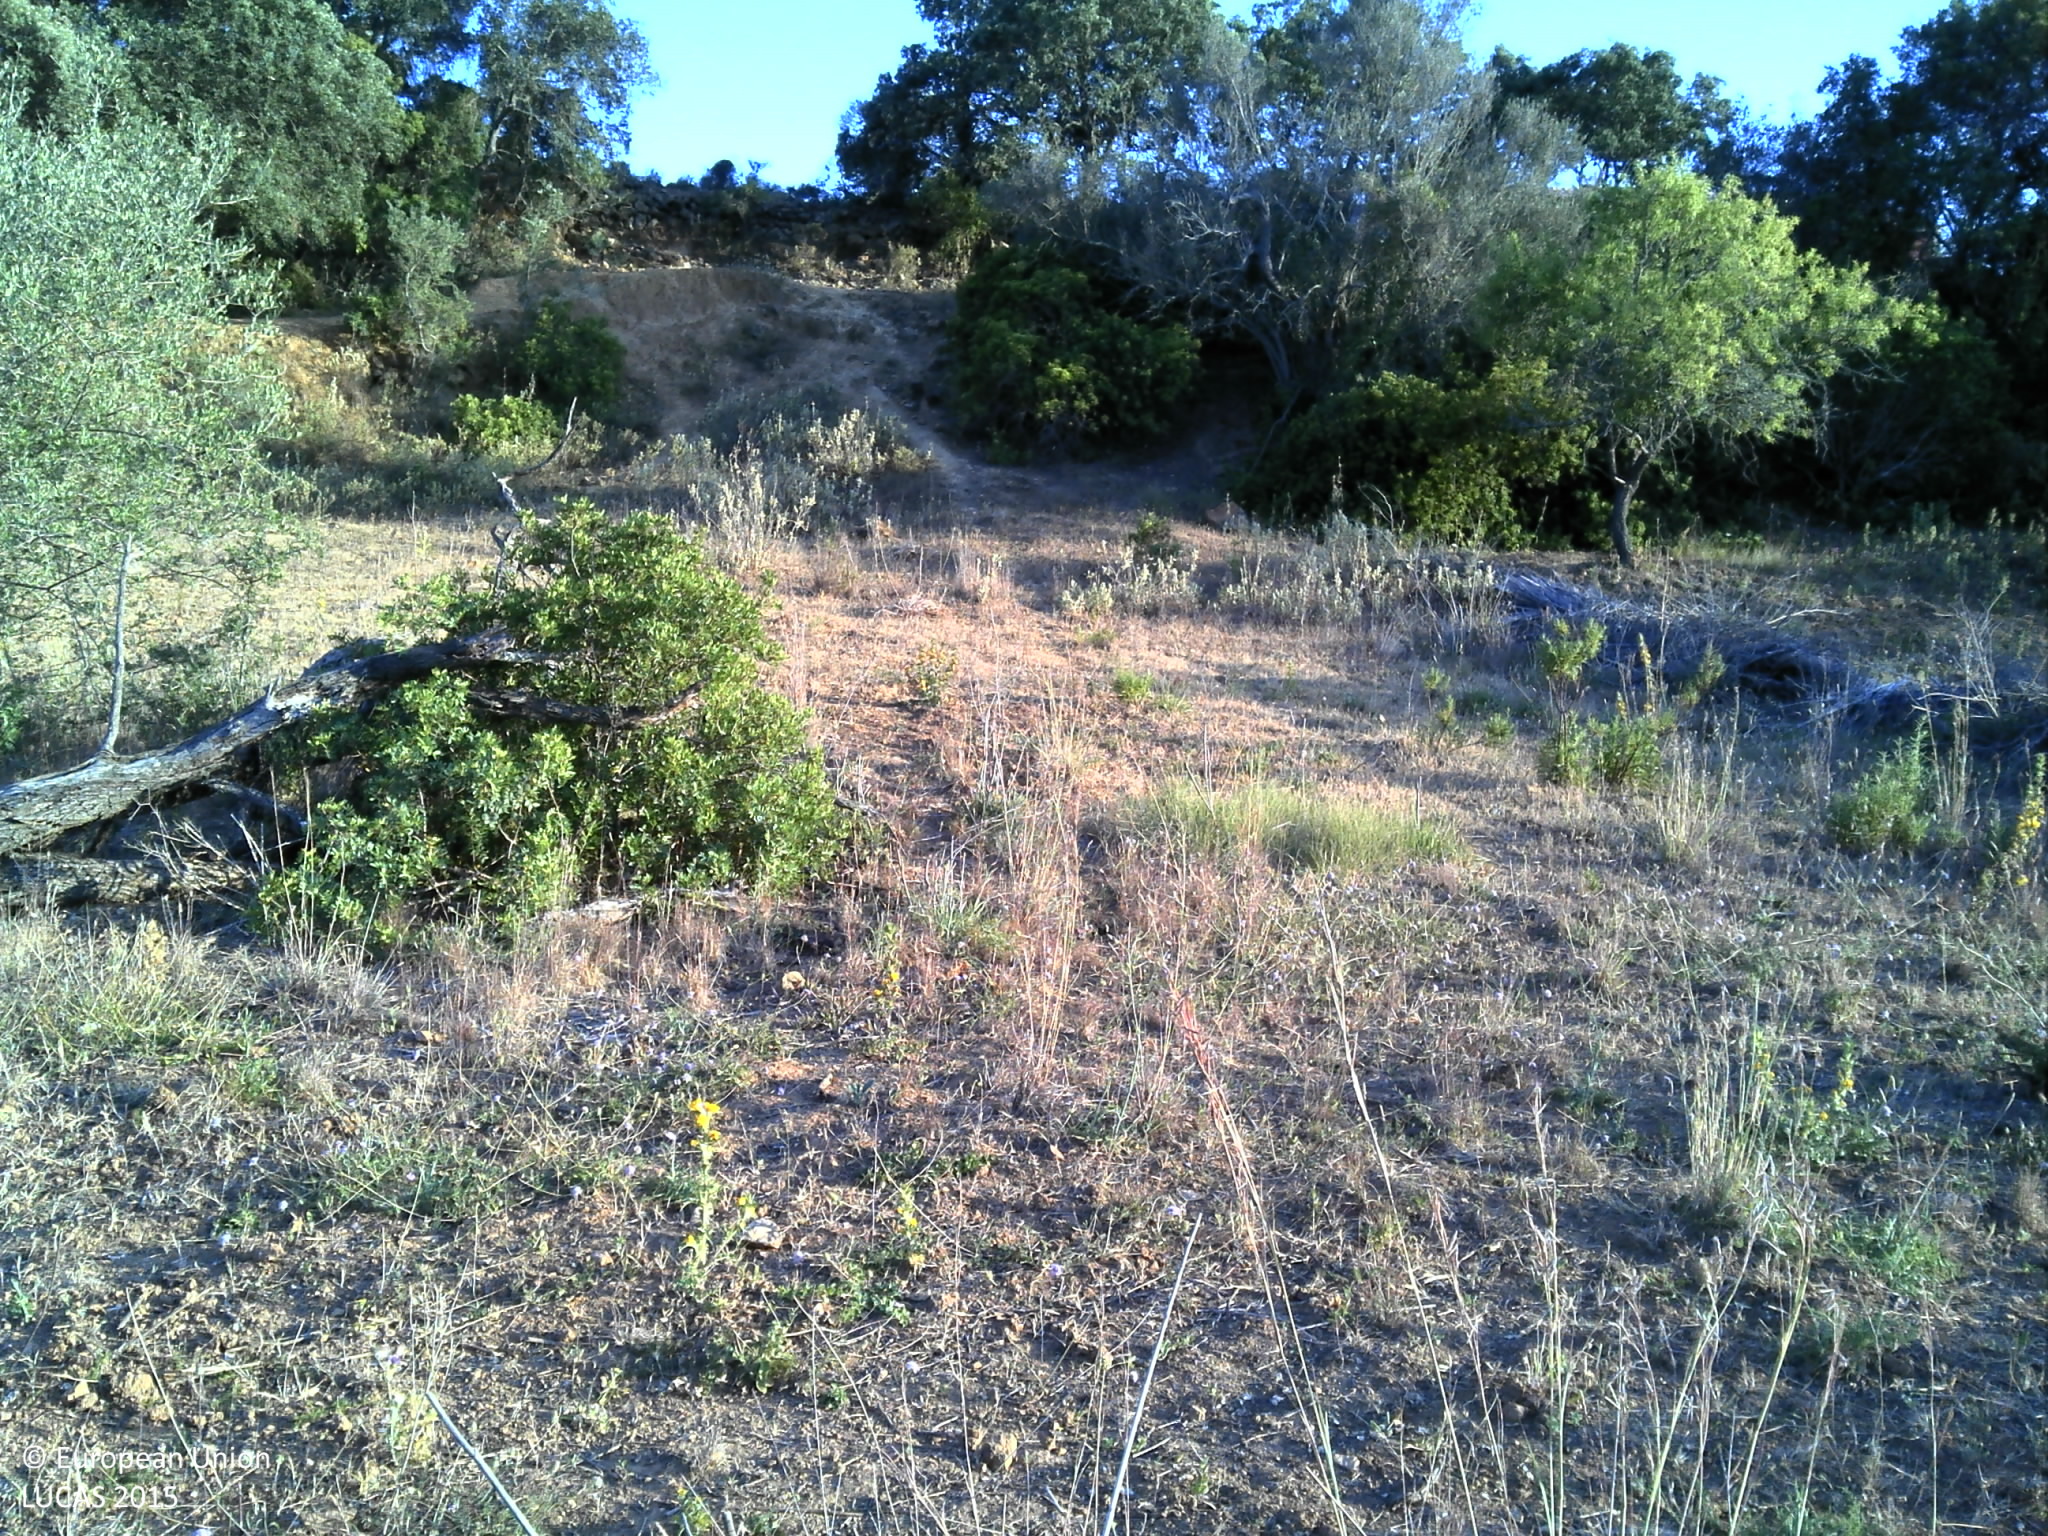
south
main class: Shrubland
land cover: Shrubland without tree cover
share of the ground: 25 - 50 %
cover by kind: shrubs 55 %, herbaceous plants 45 %
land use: Semi-natural and natural areas not in use
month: June
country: PT
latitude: 37.0518
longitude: -7.8068
